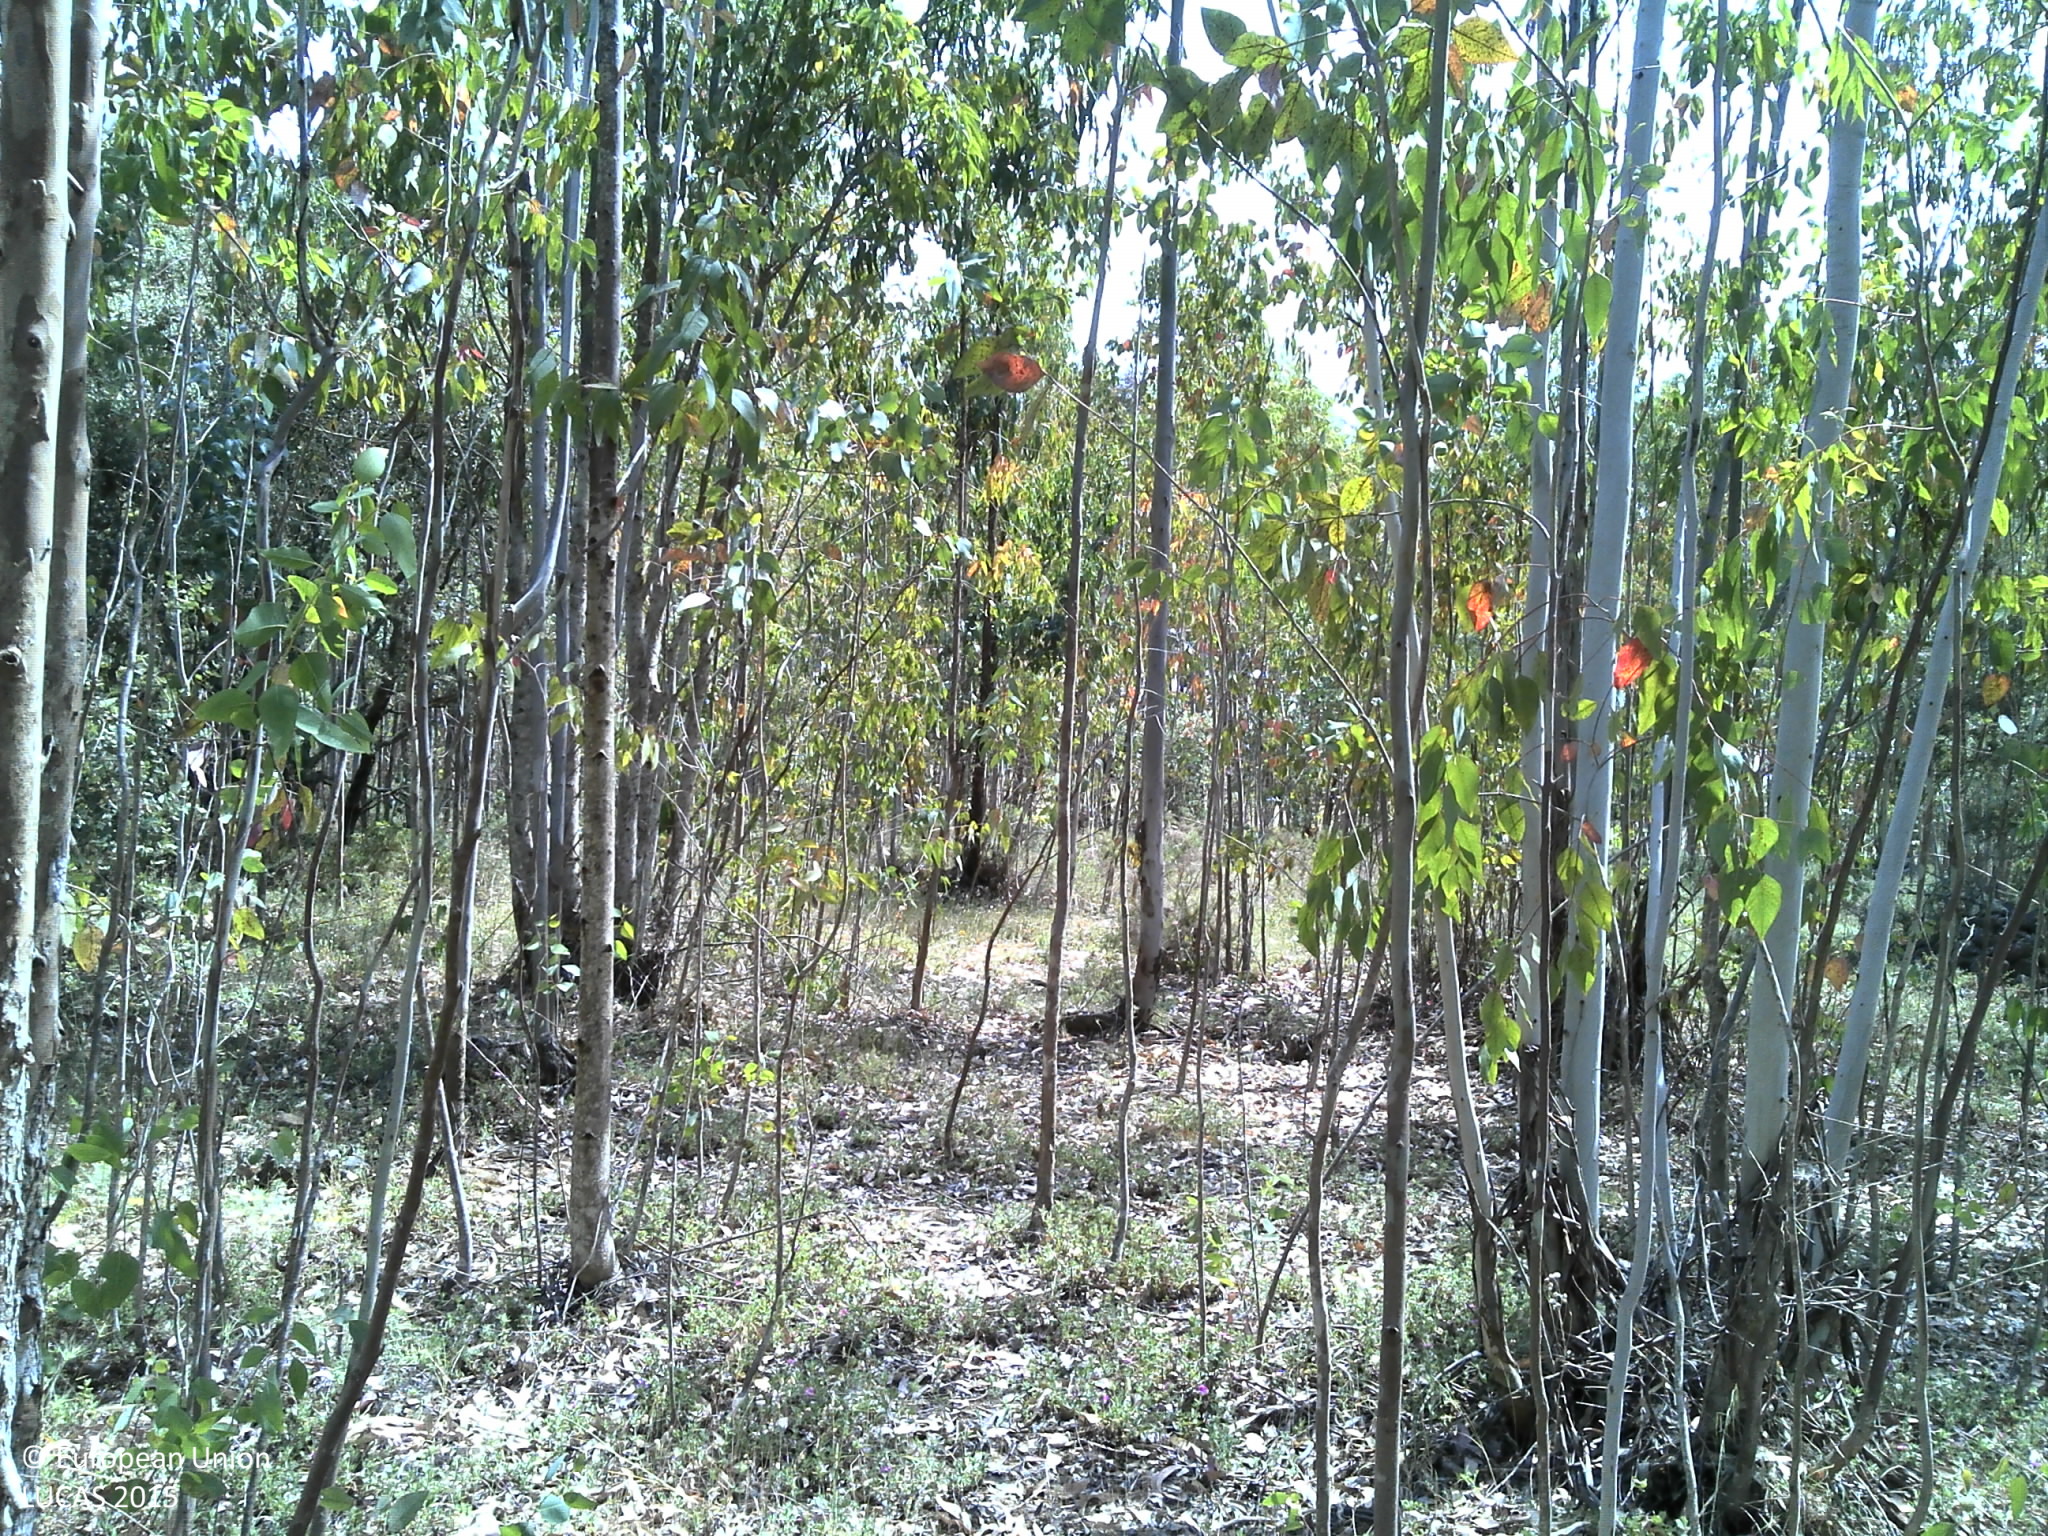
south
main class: Woodland
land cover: Broadleaved woodland
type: exotic forest
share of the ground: 50 - 75 %
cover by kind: broadleaved forest trees 75 %, herbaceous plants 10 %, unconsolidated bare surface 10 %, shrubs 5 %
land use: Forestry
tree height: > 5 m
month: May
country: PT
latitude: 39.1609
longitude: -7.5992
